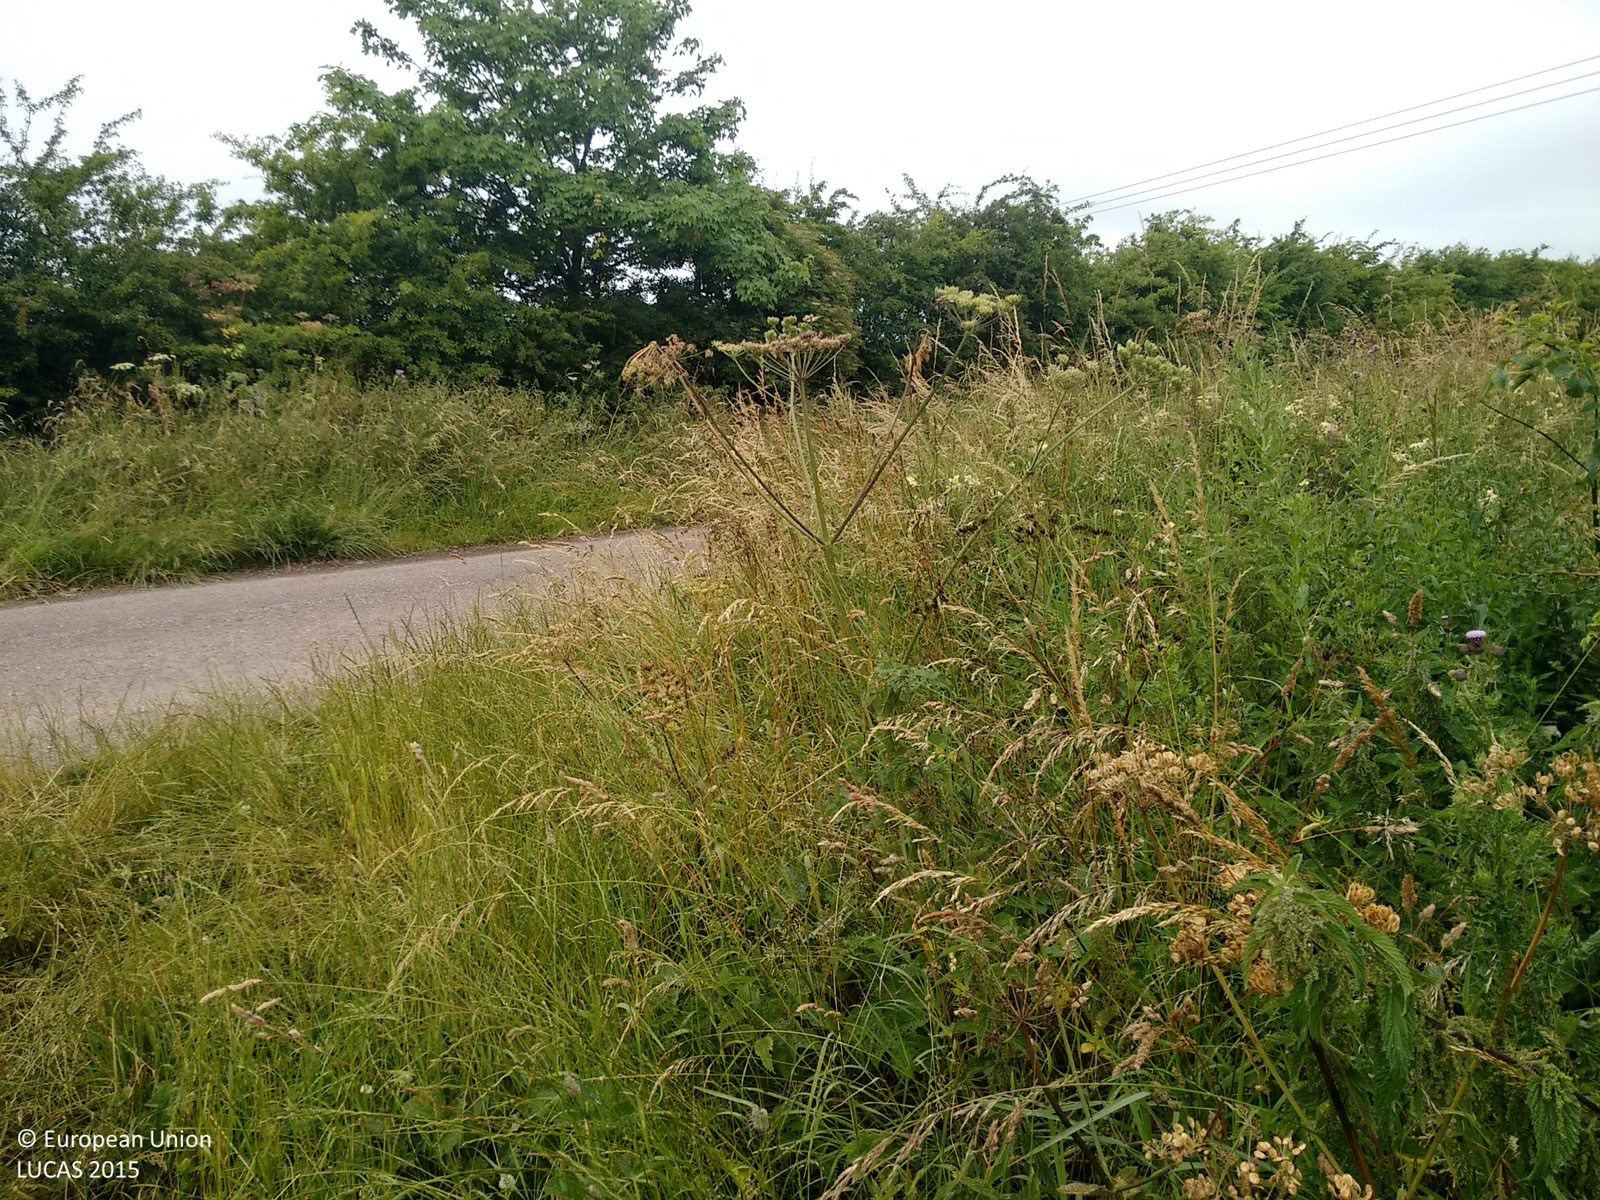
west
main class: Grassland
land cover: Grassland without tree/shrub cover
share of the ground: > 75 %
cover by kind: herbaceous plants 100 %
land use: Agriculture (excluding fallow land and kitchen gardens)
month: July
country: GB
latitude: 52.8817
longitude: -1.5681
